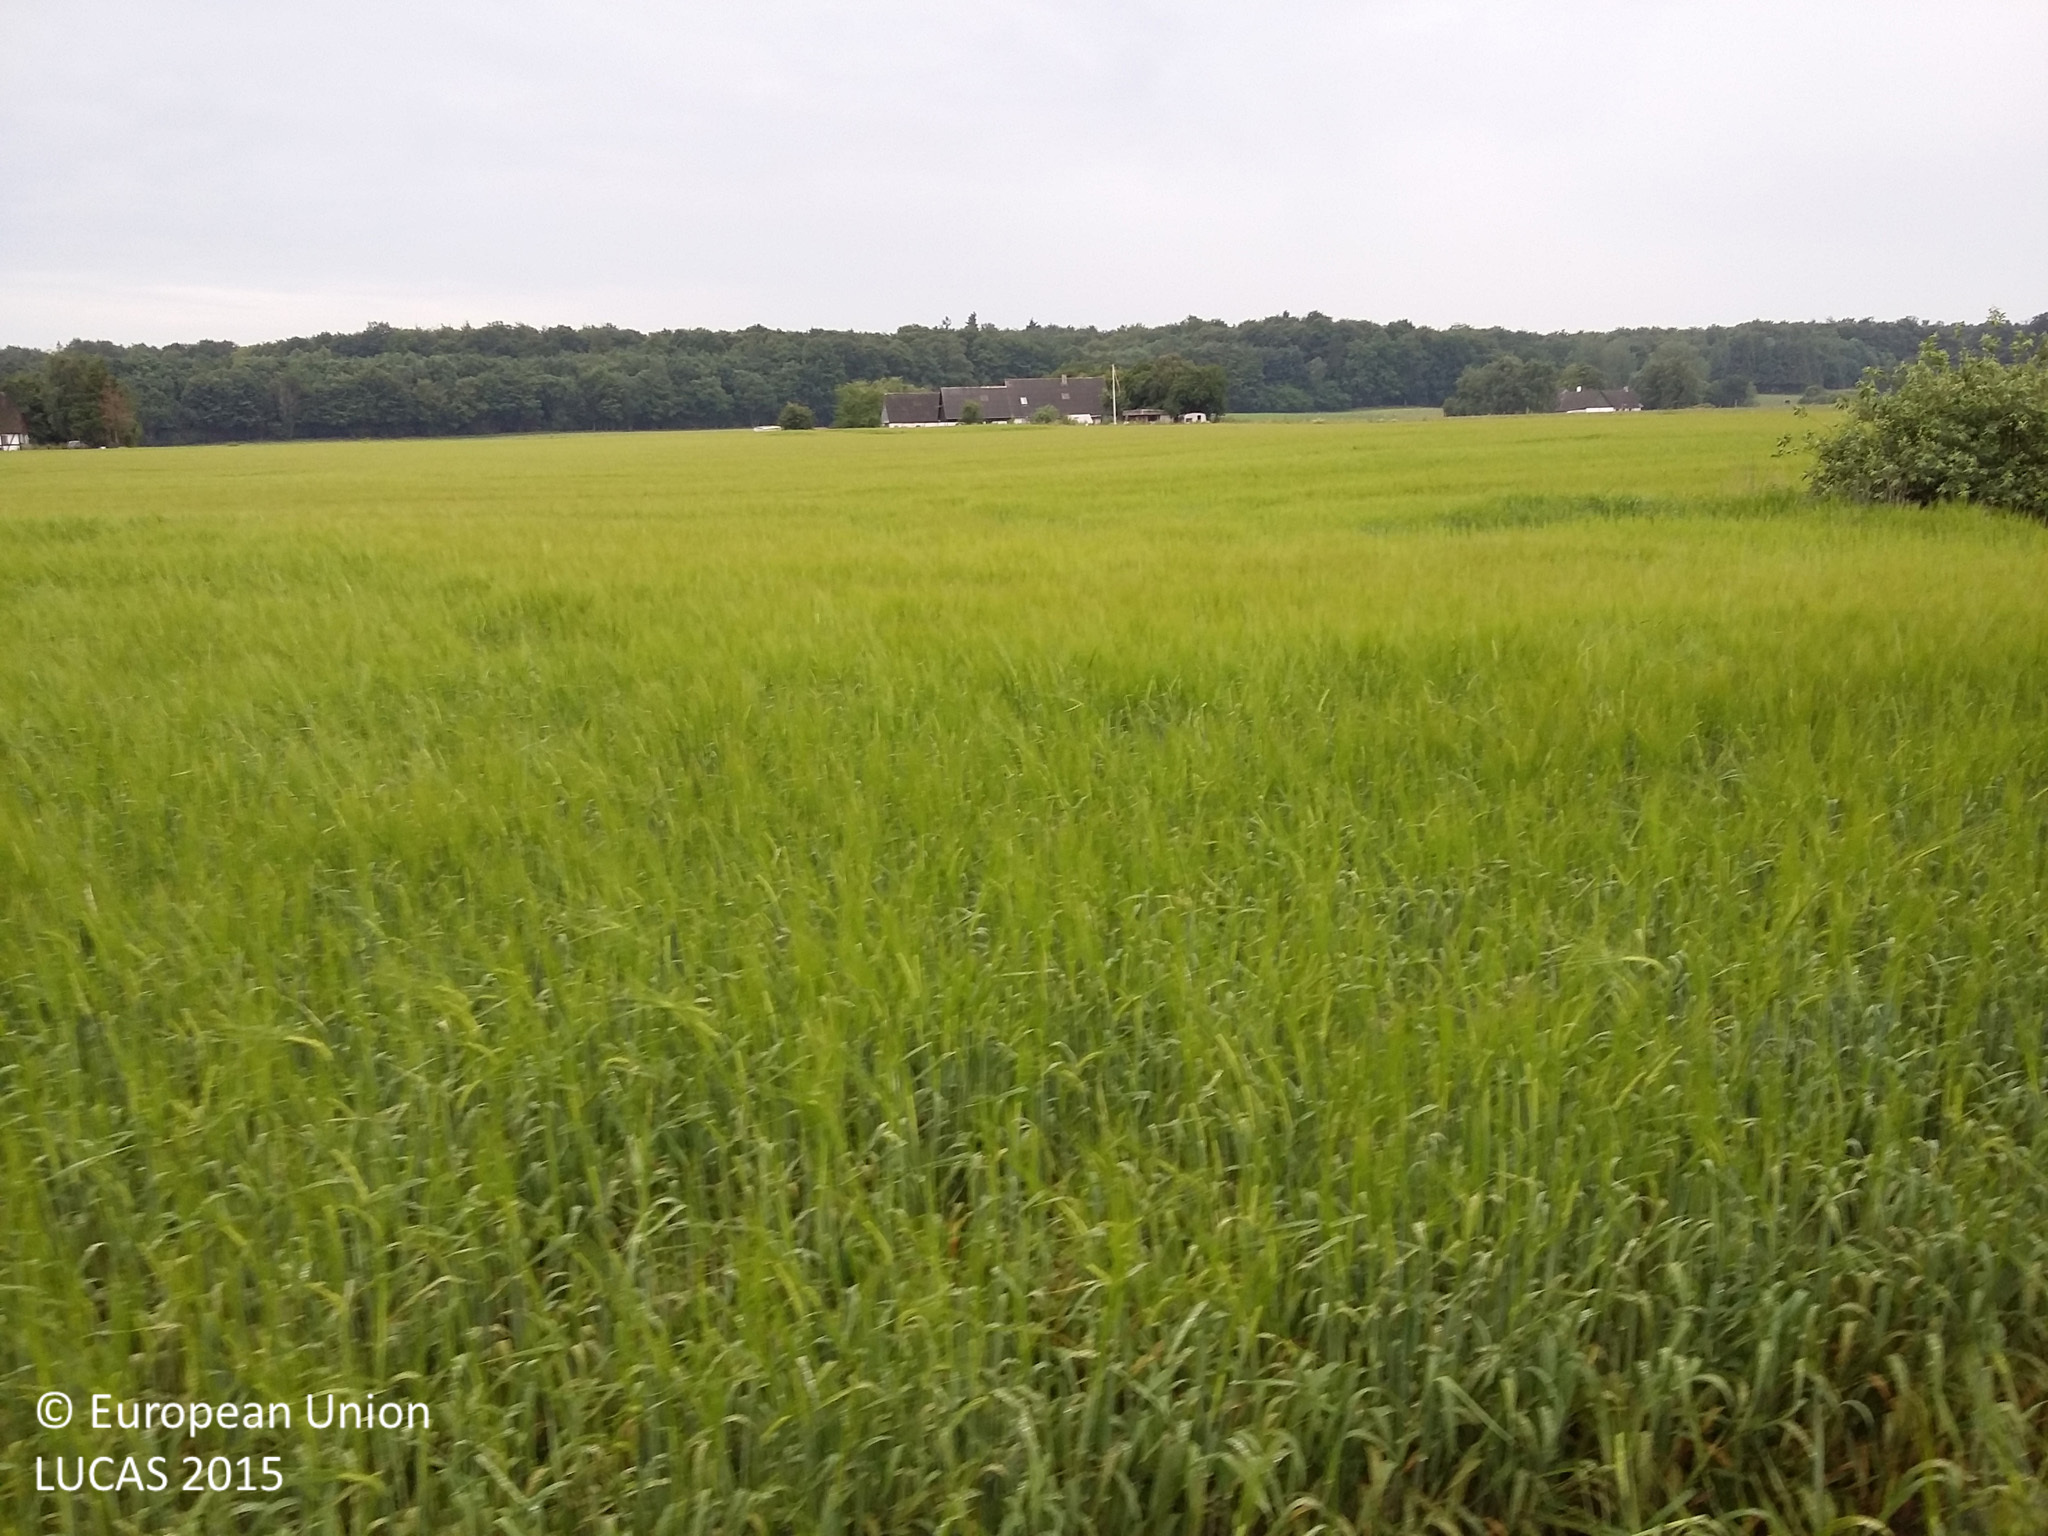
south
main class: Cropland
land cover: Barley
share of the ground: > 75 %
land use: Agriculture (excluding fallow land and kitchen gardens)
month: July
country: DK
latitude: 55.3145
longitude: 11.6216
